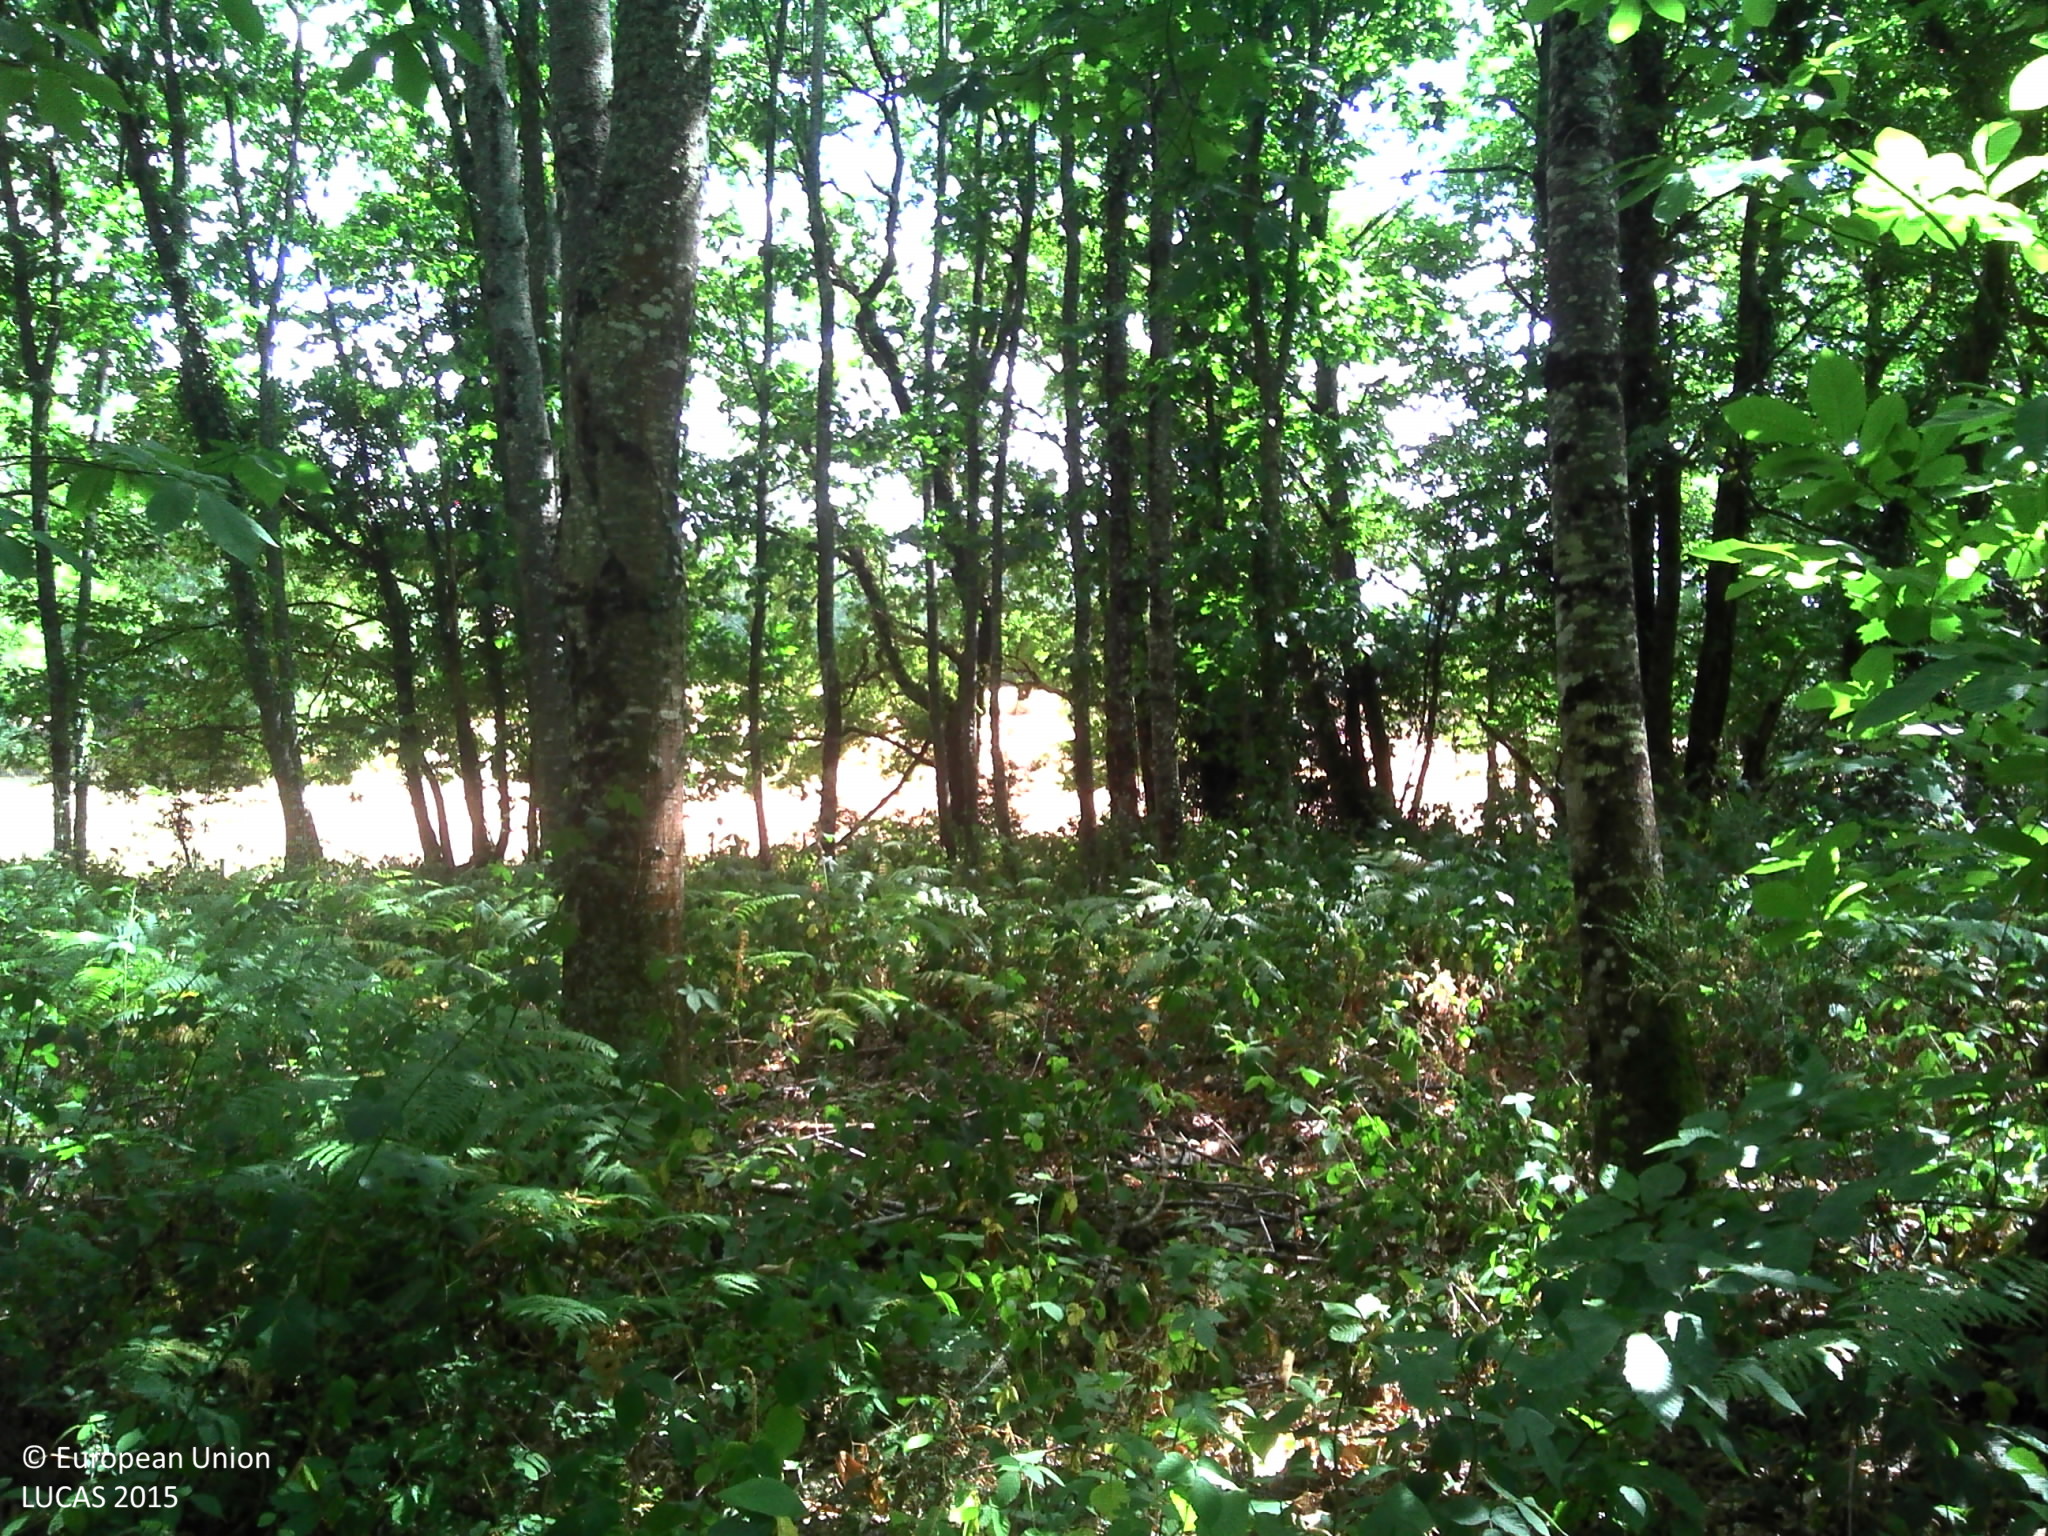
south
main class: Woodland
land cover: Broadleaved woodland
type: exotic forest
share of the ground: > 75 %
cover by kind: broadleaved forest trees 100 %
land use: Forestry
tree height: > 5 m
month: July
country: FR
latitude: 45.9706
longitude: 0.9933
